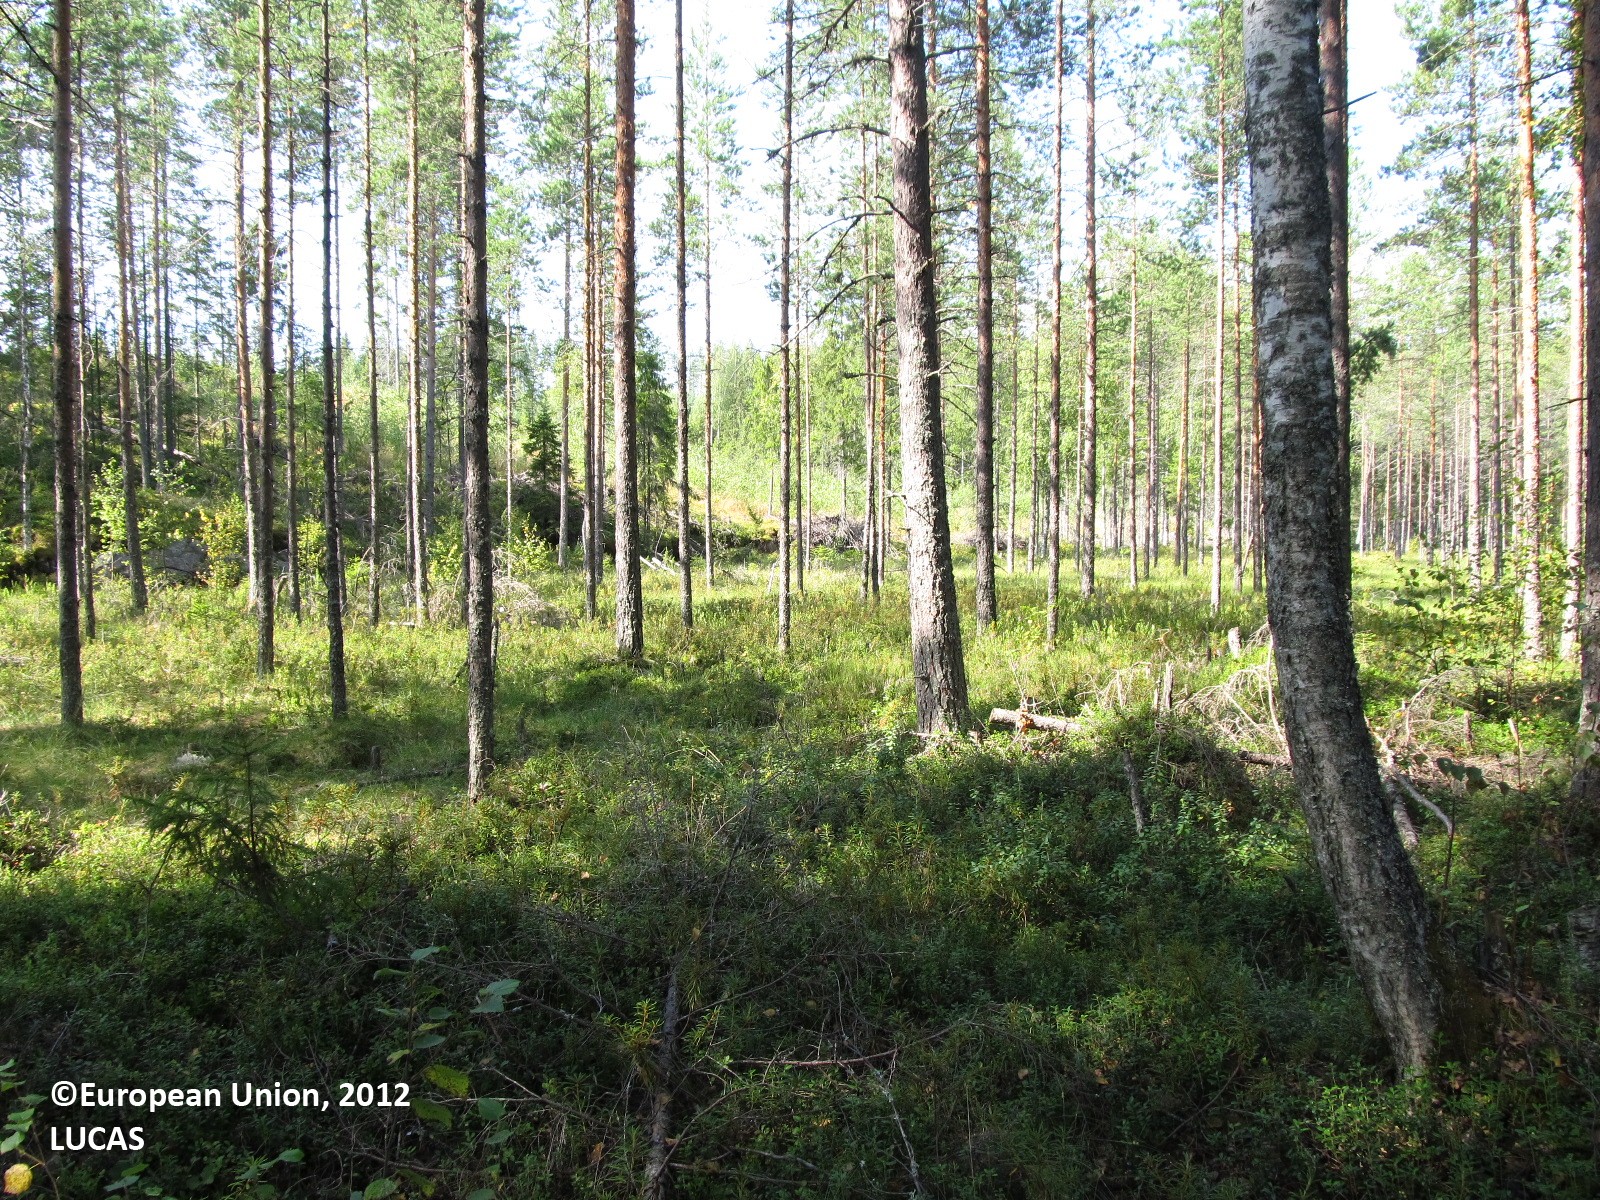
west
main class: Woodland
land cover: Pine dominated mixed woodland
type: boreal forest
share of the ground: > 75 %
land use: Forestry
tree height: > 5 m
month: August
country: FI
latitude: 62.4152
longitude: 27.4531
